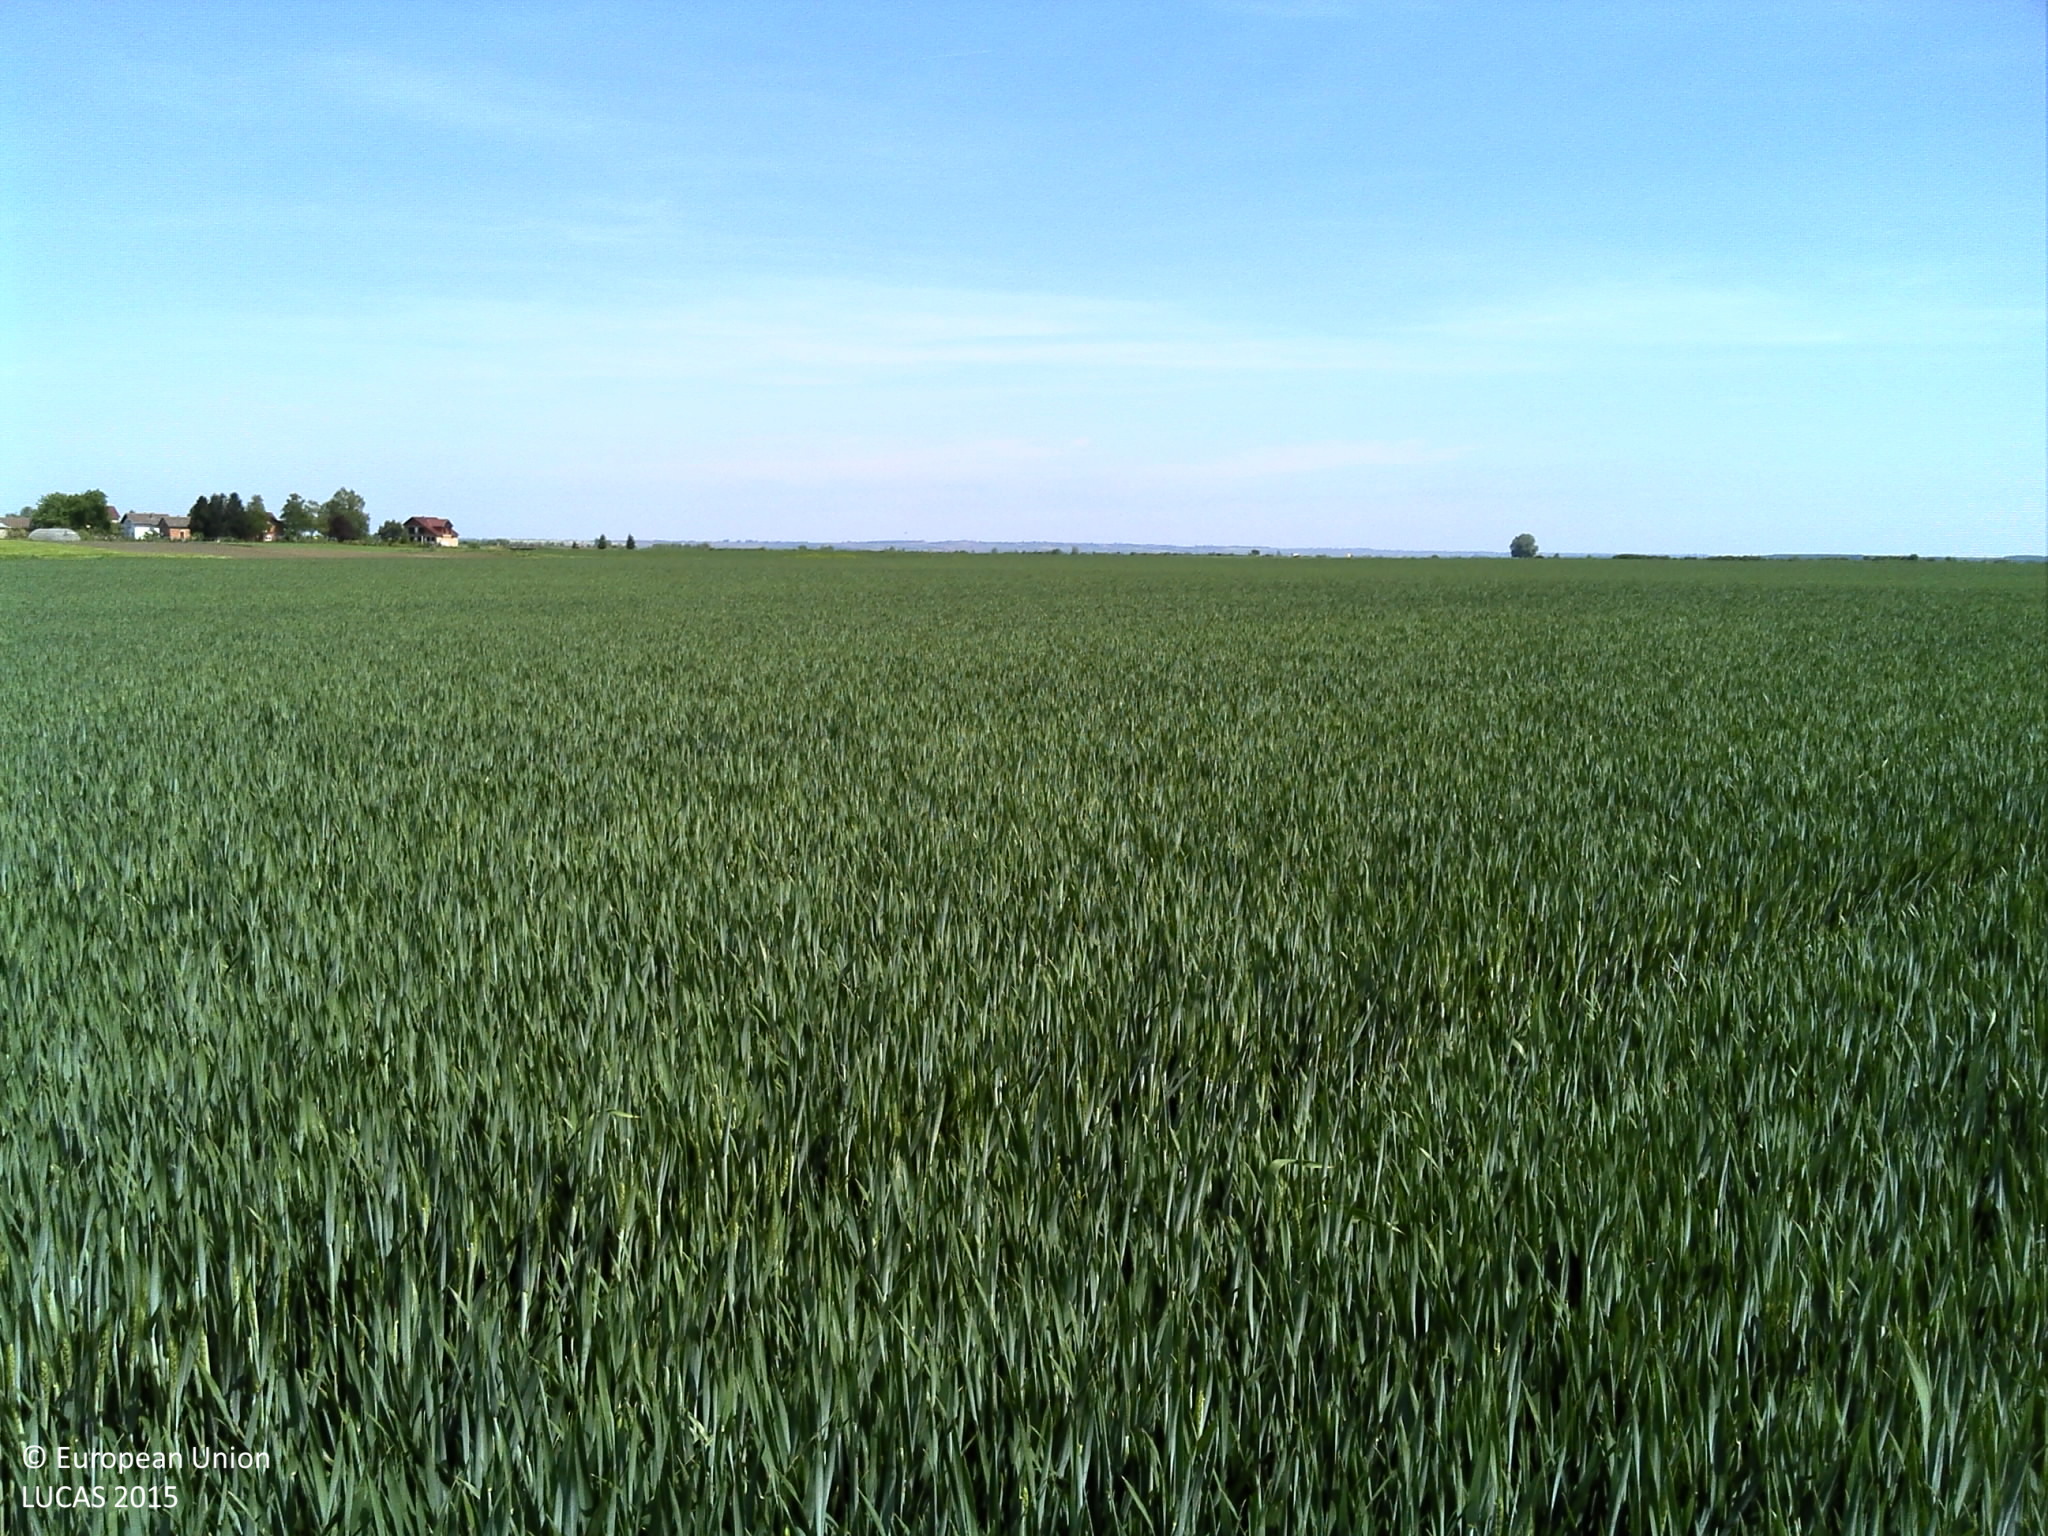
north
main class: Cropland
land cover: Common wheat
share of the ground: > 75 %
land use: Agriculture (excluding fallow land and kitchen gardens)
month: May
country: HR
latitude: 45.3987
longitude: 18.9124
